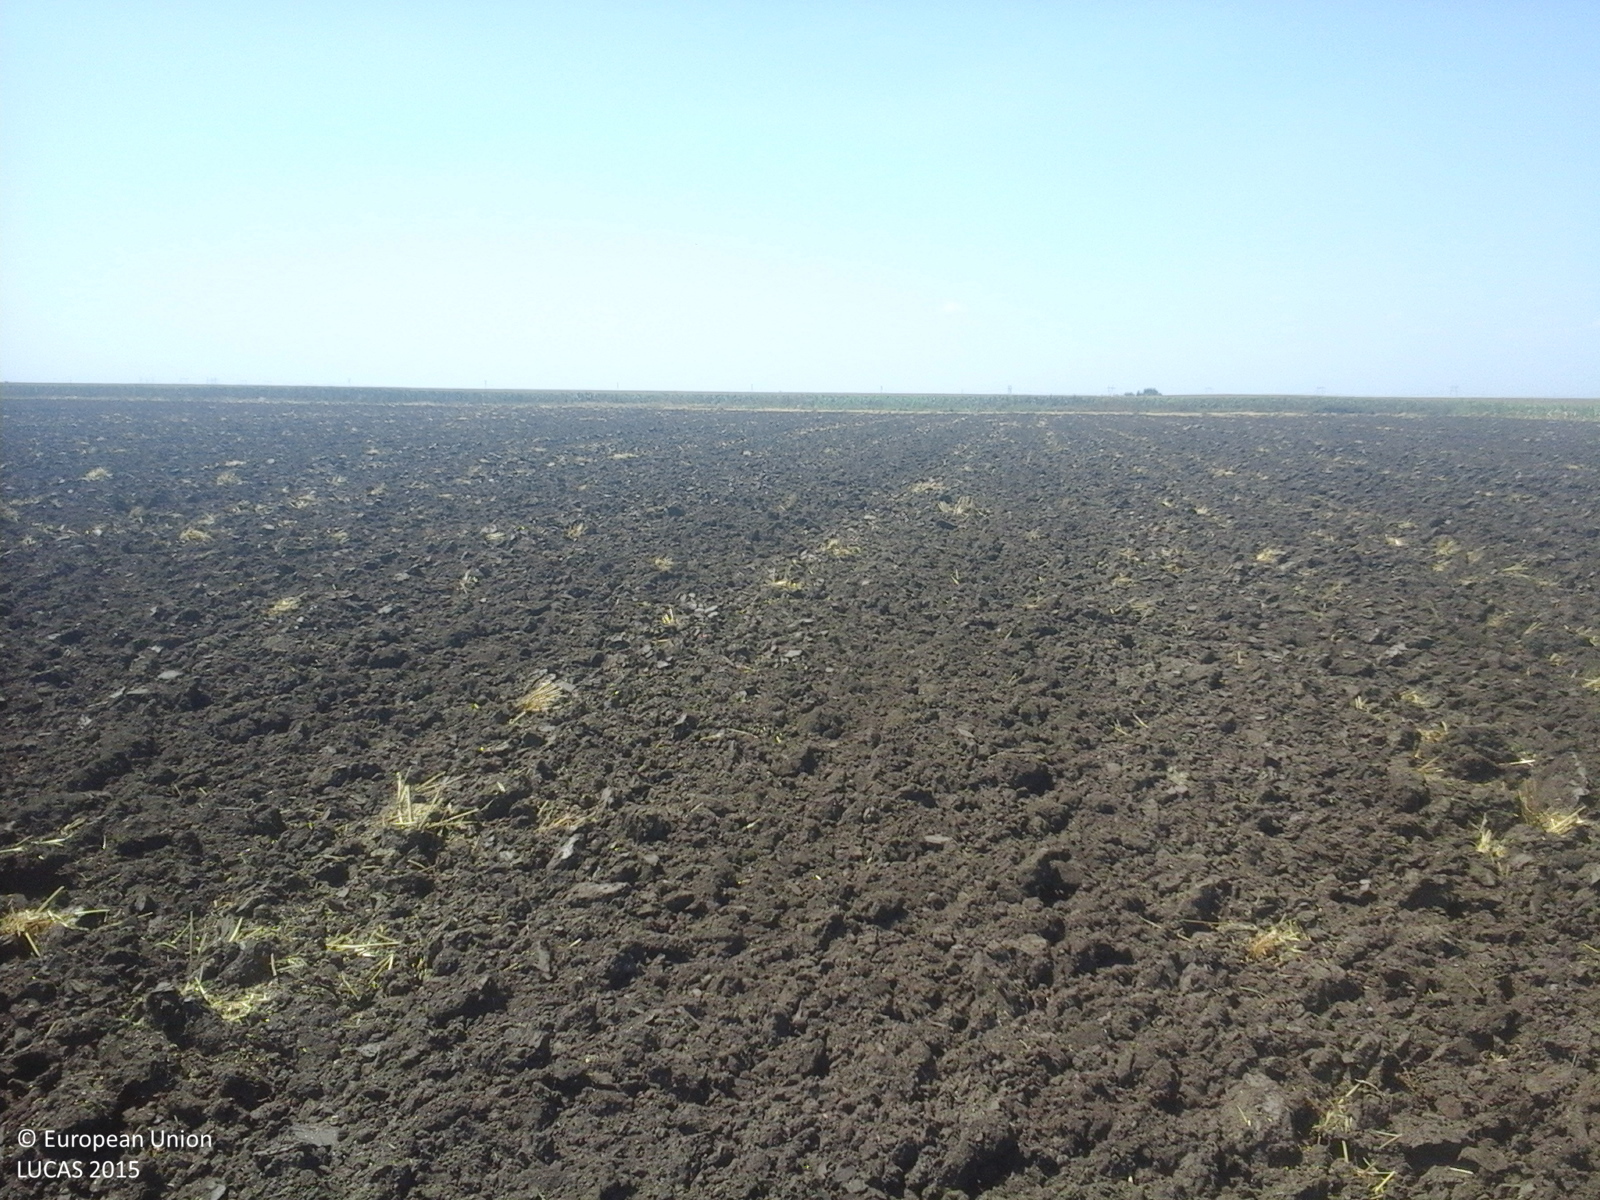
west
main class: Cropland
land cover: Common wheat
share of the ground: < 10 %
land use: Agriculture (excluding fallow land and kitchen gardens)
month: July
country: RO
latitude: 44.2358
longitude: 27.1454
